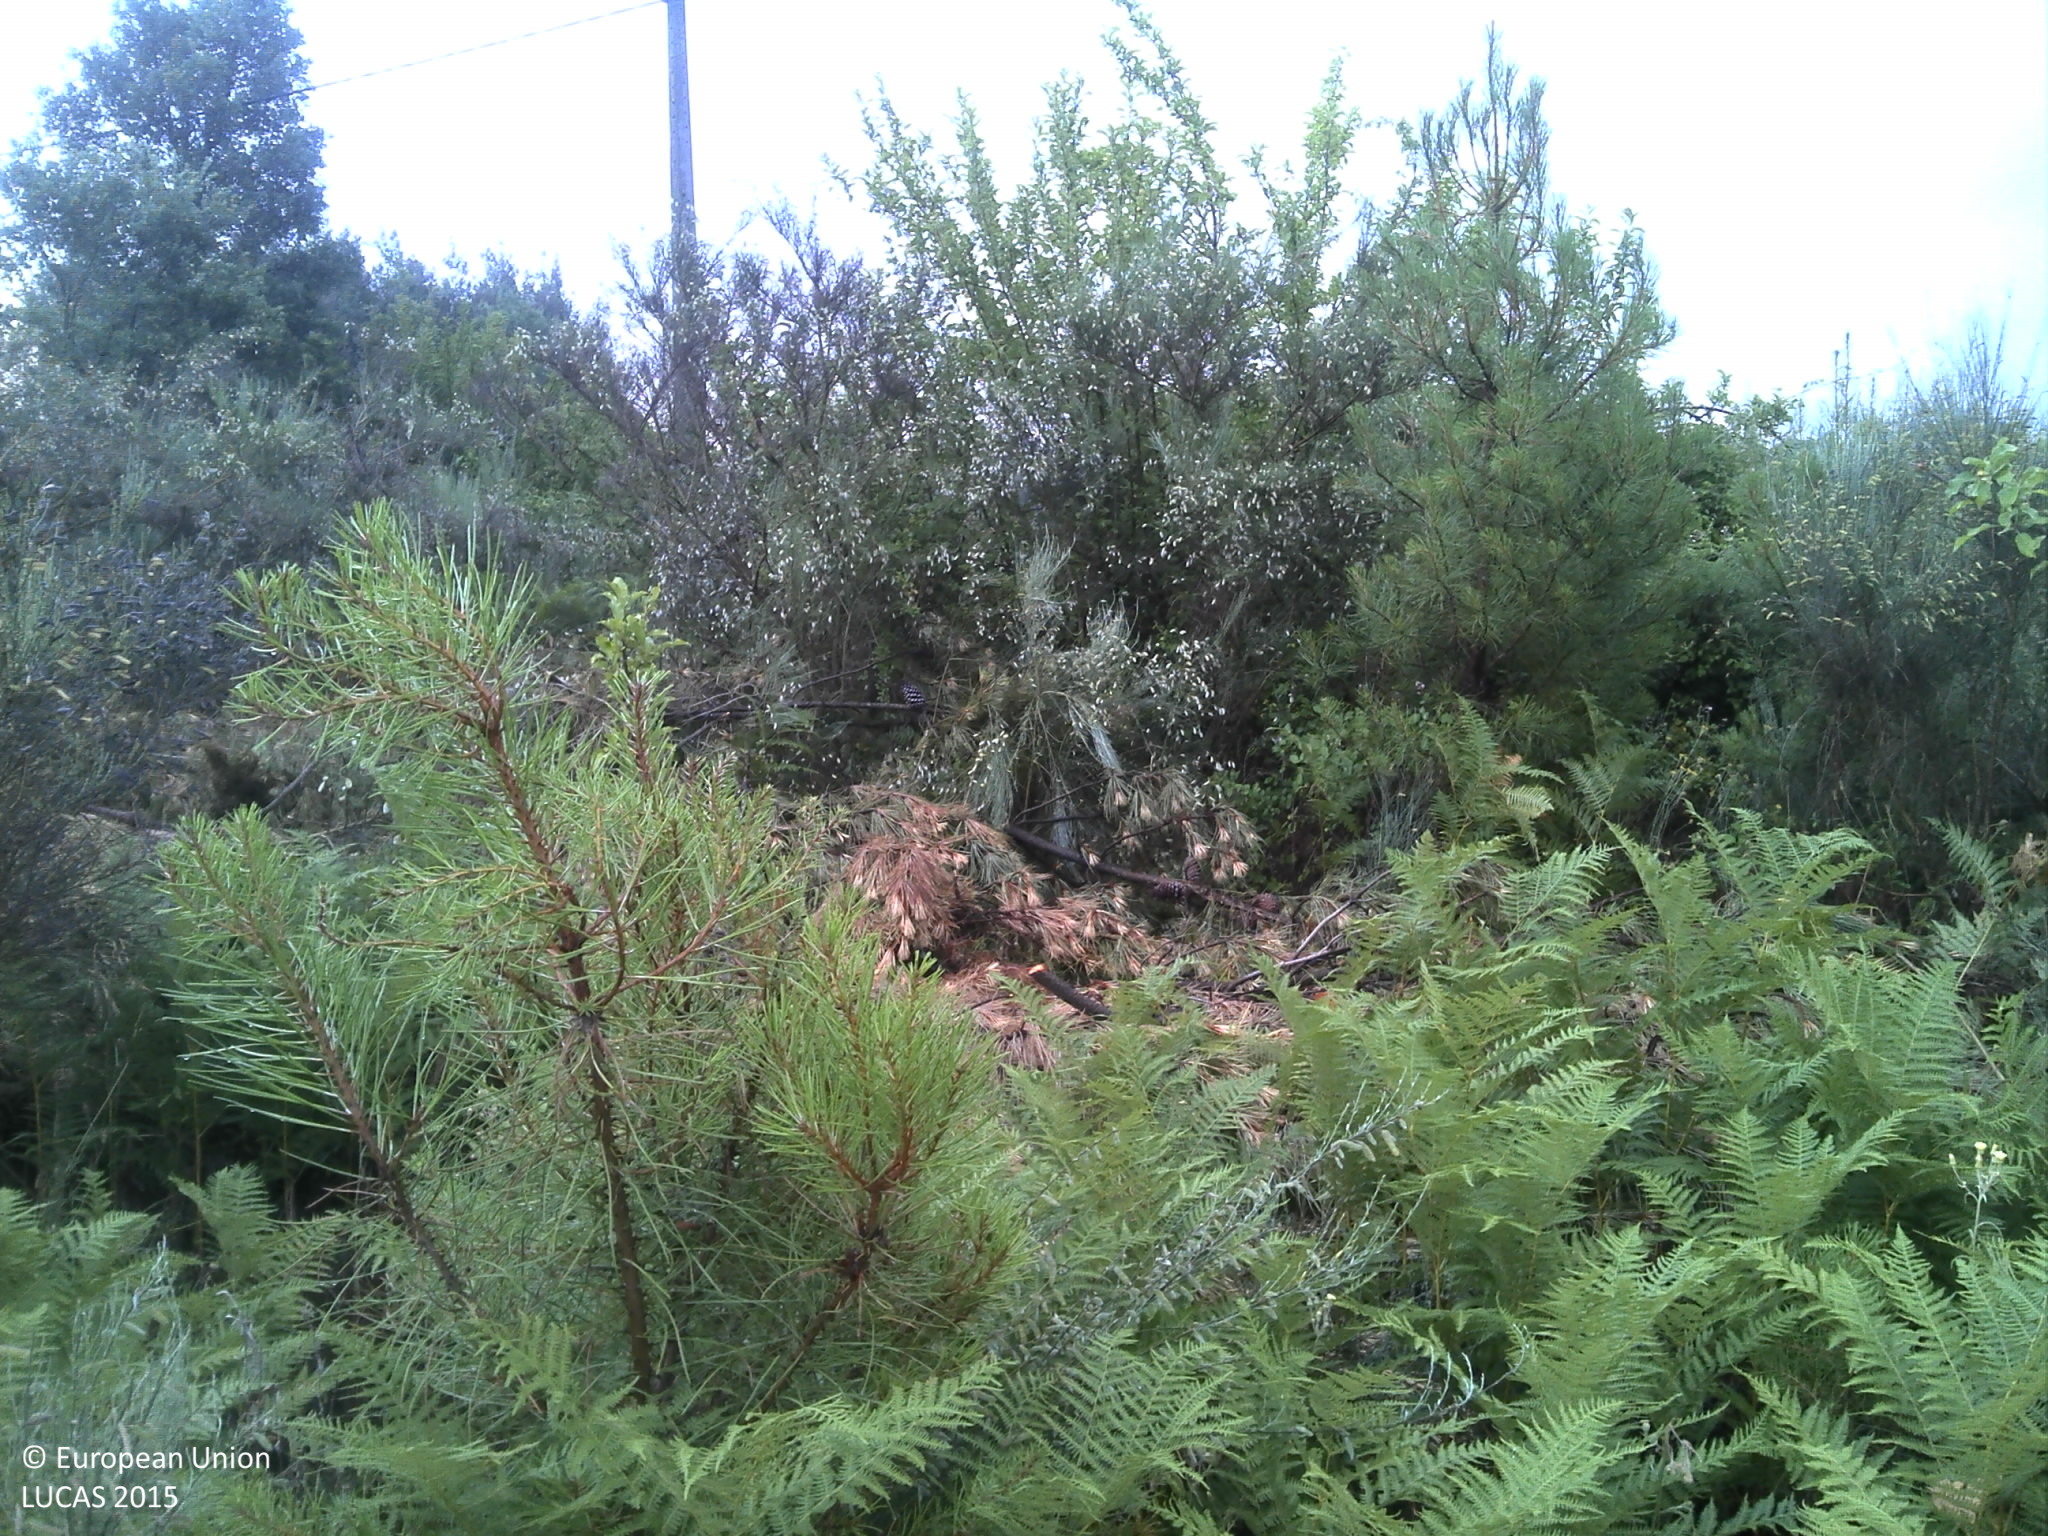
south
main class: Shrubland
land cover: Shrubland with sparse tree cover
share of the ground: 25 - 50 %
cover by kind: unconsolidated bare surface 45 %, shrubs 40 %, herbaceous plants 10 %, broadleaved forest trees 5 %
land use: Forestry
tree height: < 5 m
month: June
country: PT
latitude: 40.2062
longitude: -7.4336
